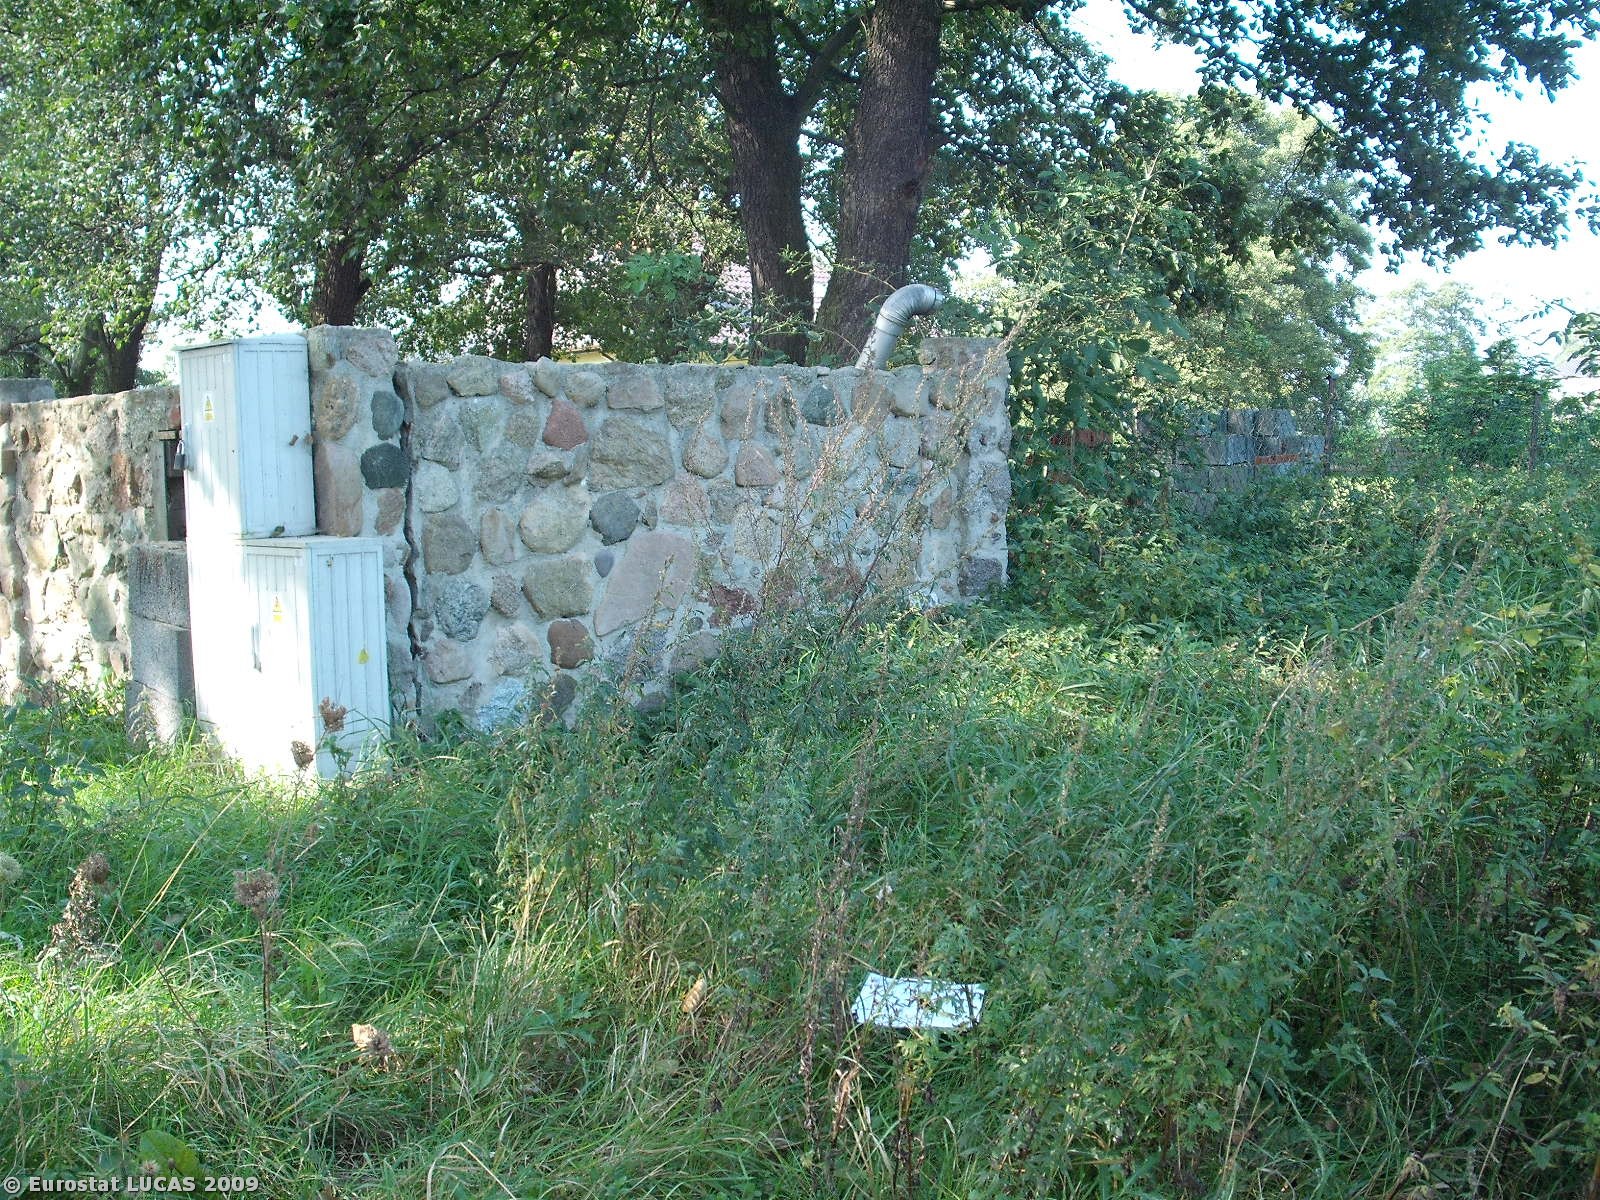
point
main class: Grassland
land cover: Spontaneously vegetated surfaces
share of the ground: > 75 %
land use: Unused
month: September
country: PL
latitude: 52.0351
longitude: 20.7261
